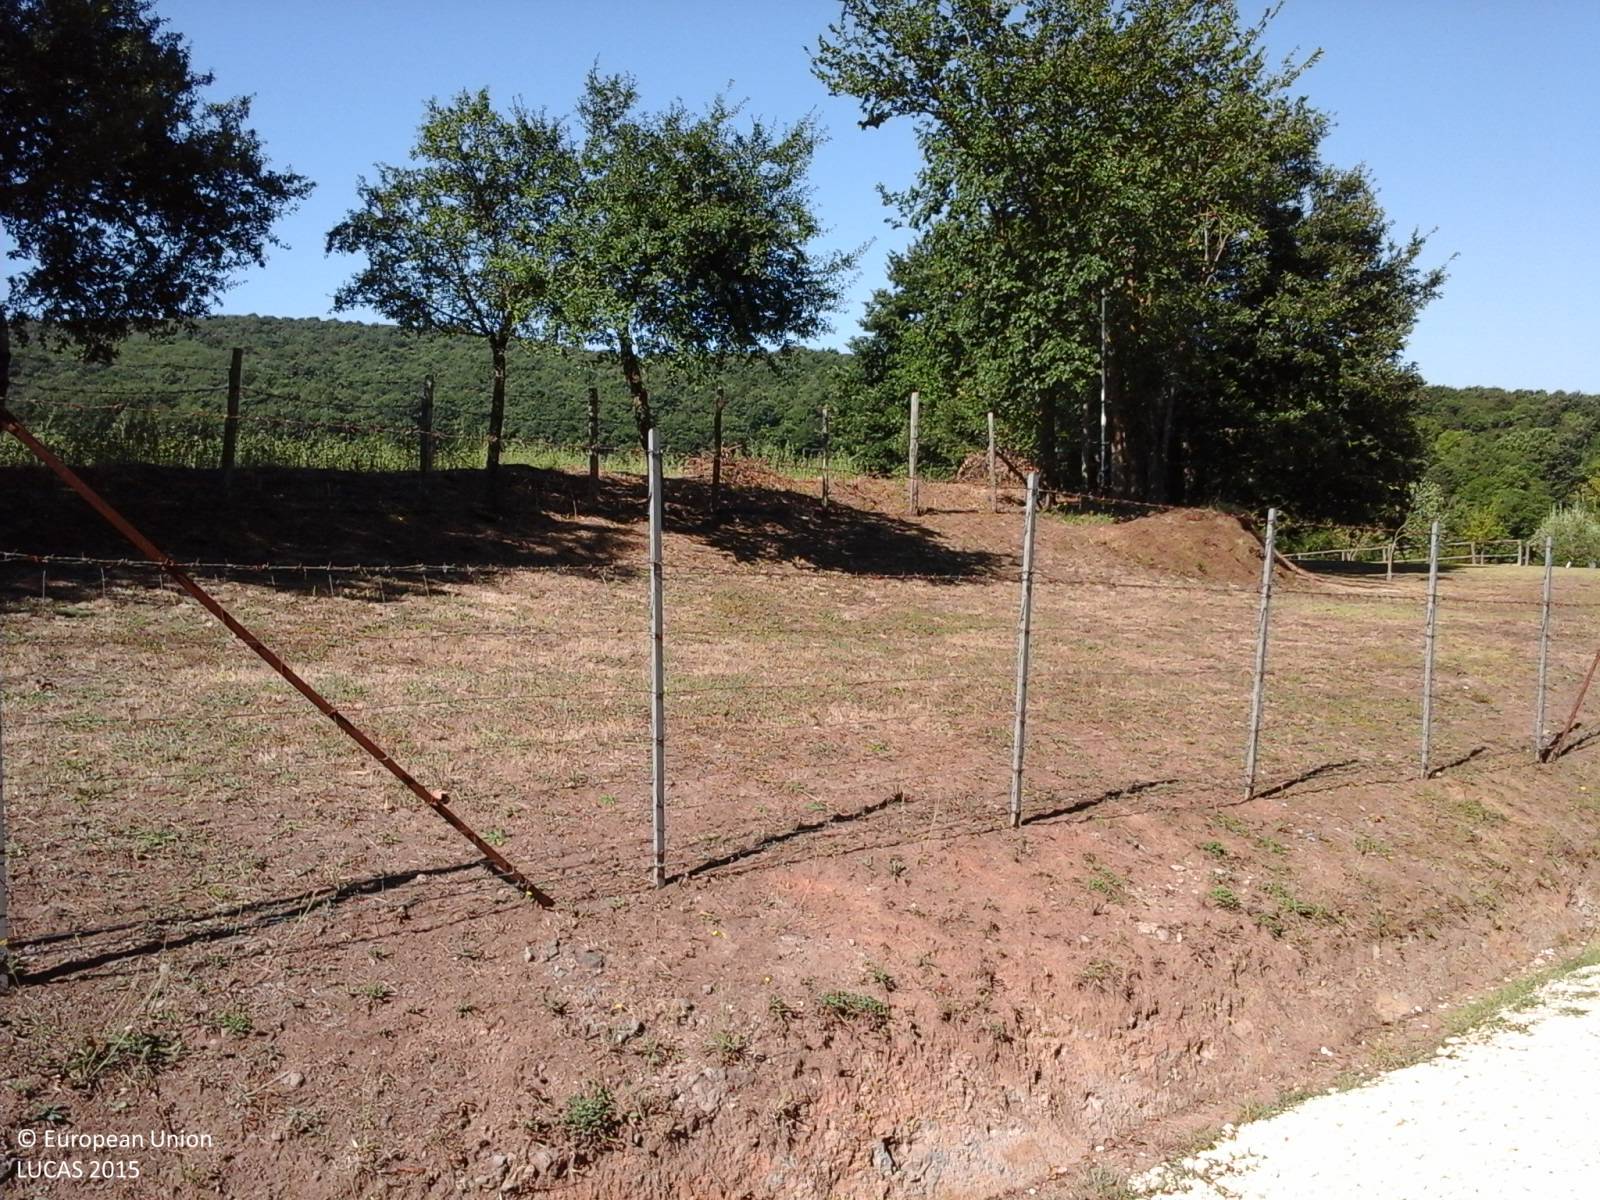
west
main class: Woodland
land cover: Broadleaved woodland
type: thermophilous deciduous forest
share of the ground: > 75 %
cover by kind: broadleaved forest trees 100 %
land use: Forestry
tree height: > 5 m
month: July
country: IT
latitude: 42.1552
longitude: 12.4239
